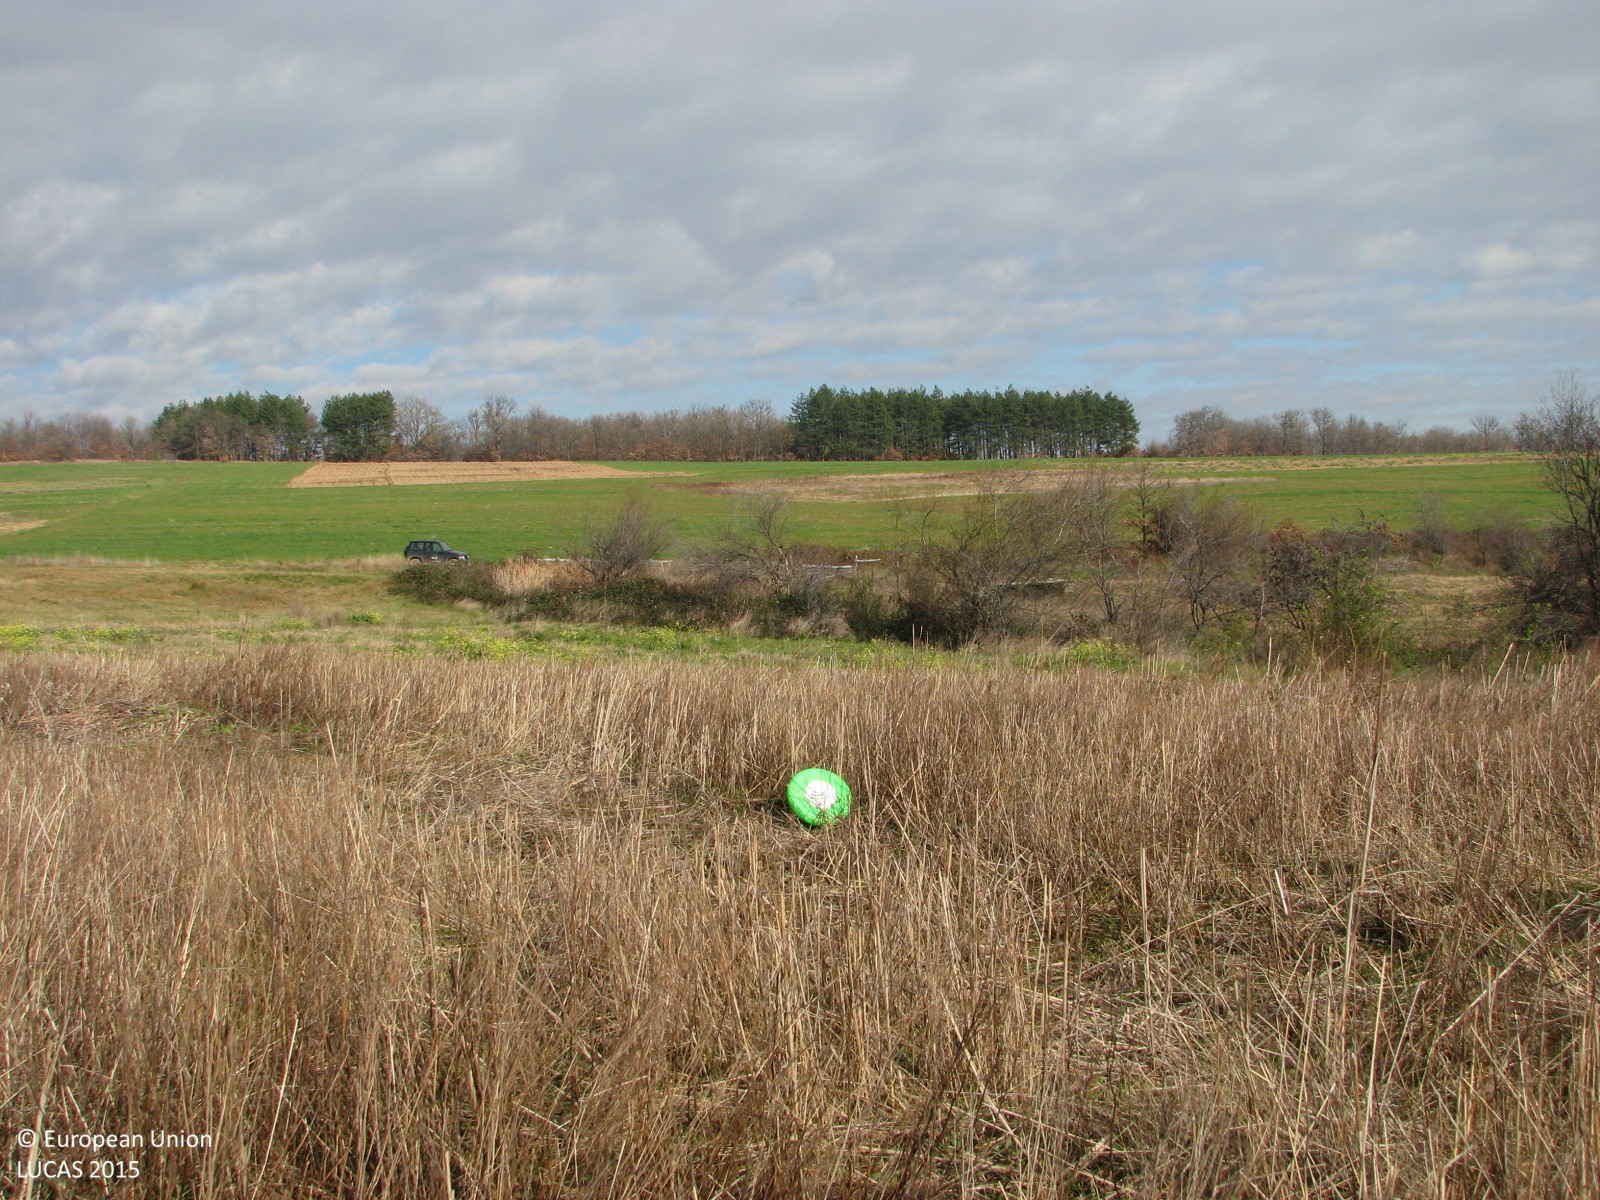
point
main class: Cropland
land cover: Rye
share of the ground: > 75 %
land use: Agriculture (excluding fallow land and kitchen gardens)
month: December
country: BG
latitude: 42.4897
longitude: 24.0717
